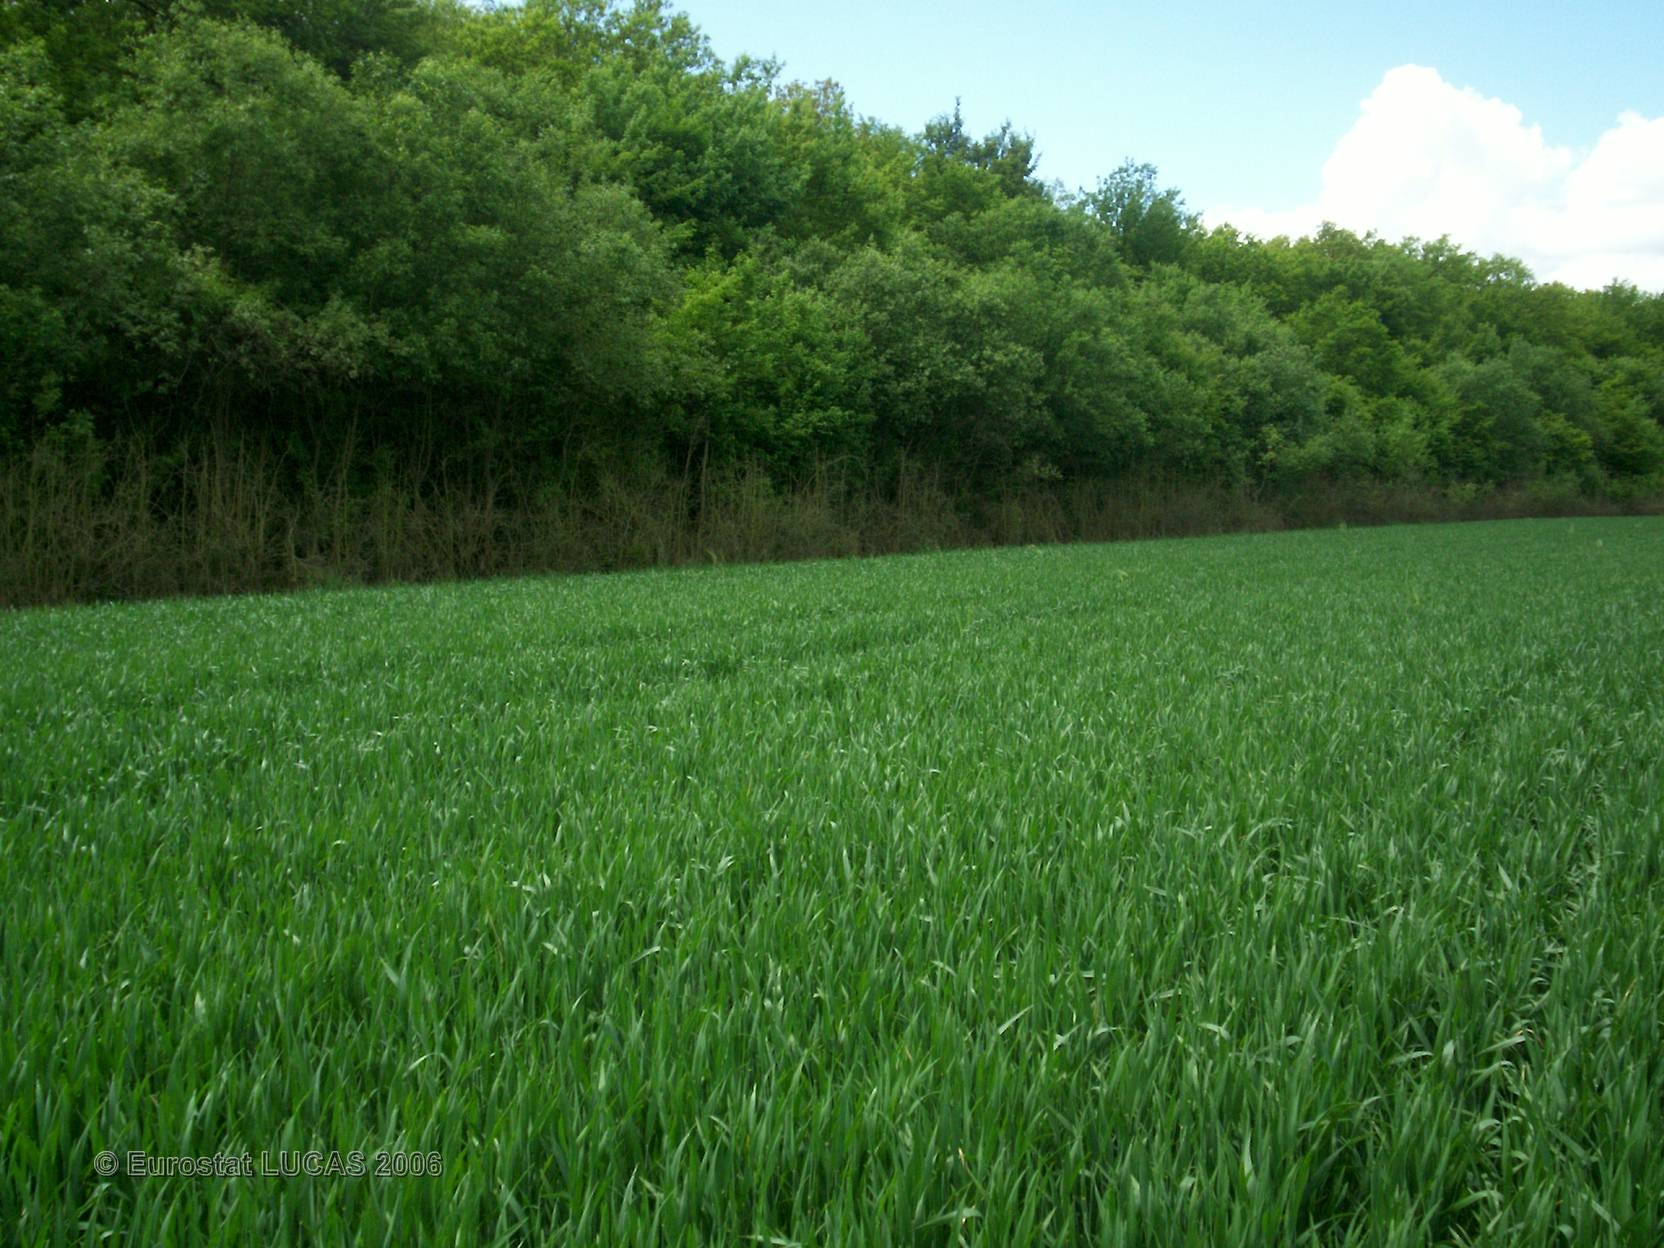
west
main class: Cropland
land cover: Common wheat
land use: Agriculture (excluding fallow land and kitchen gardens)
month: May
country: FR
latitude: 49.2269
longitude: 5.8661
